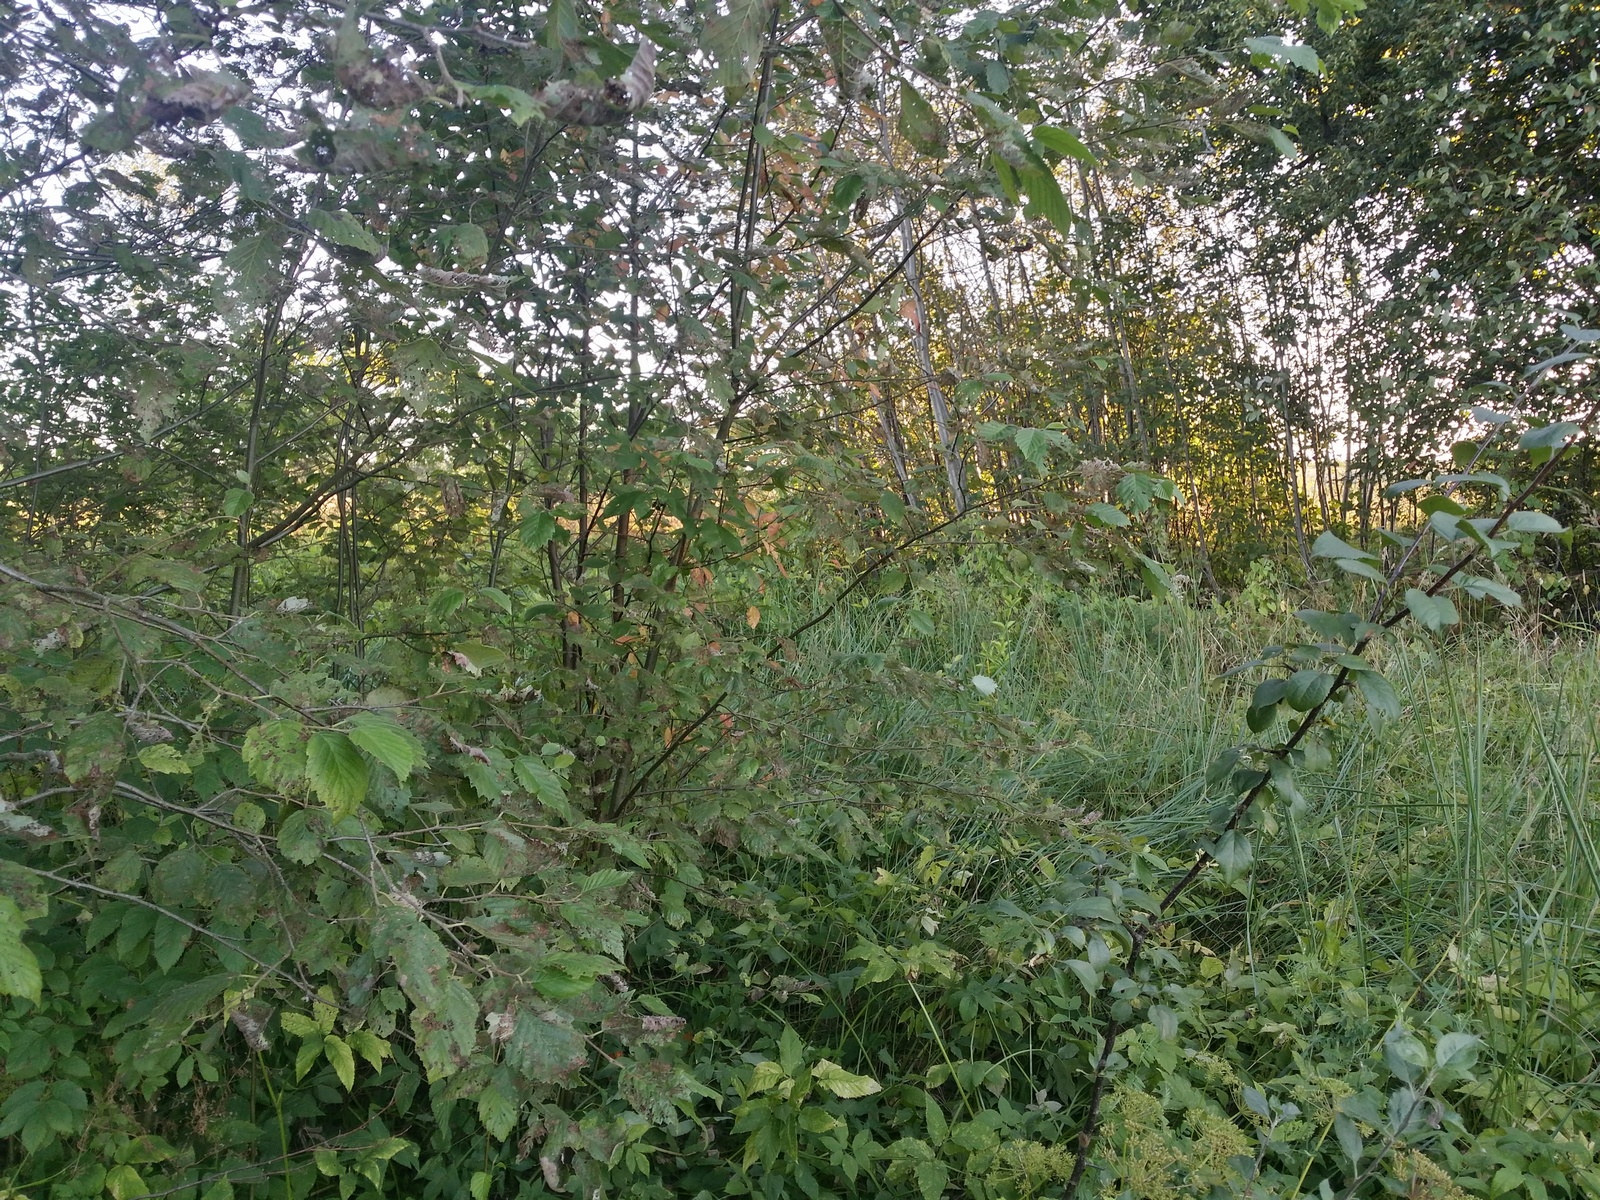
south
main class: Grassland
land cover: Spontaneously vegetated surfaces
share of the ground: > 75 %
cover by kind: herbaceous plants 95 %, shrubs 5 %
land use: Semi-natural and natural areas not in use
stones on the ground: < 10 %
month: August
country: LV
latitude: 57.1543
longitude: 26.7663
